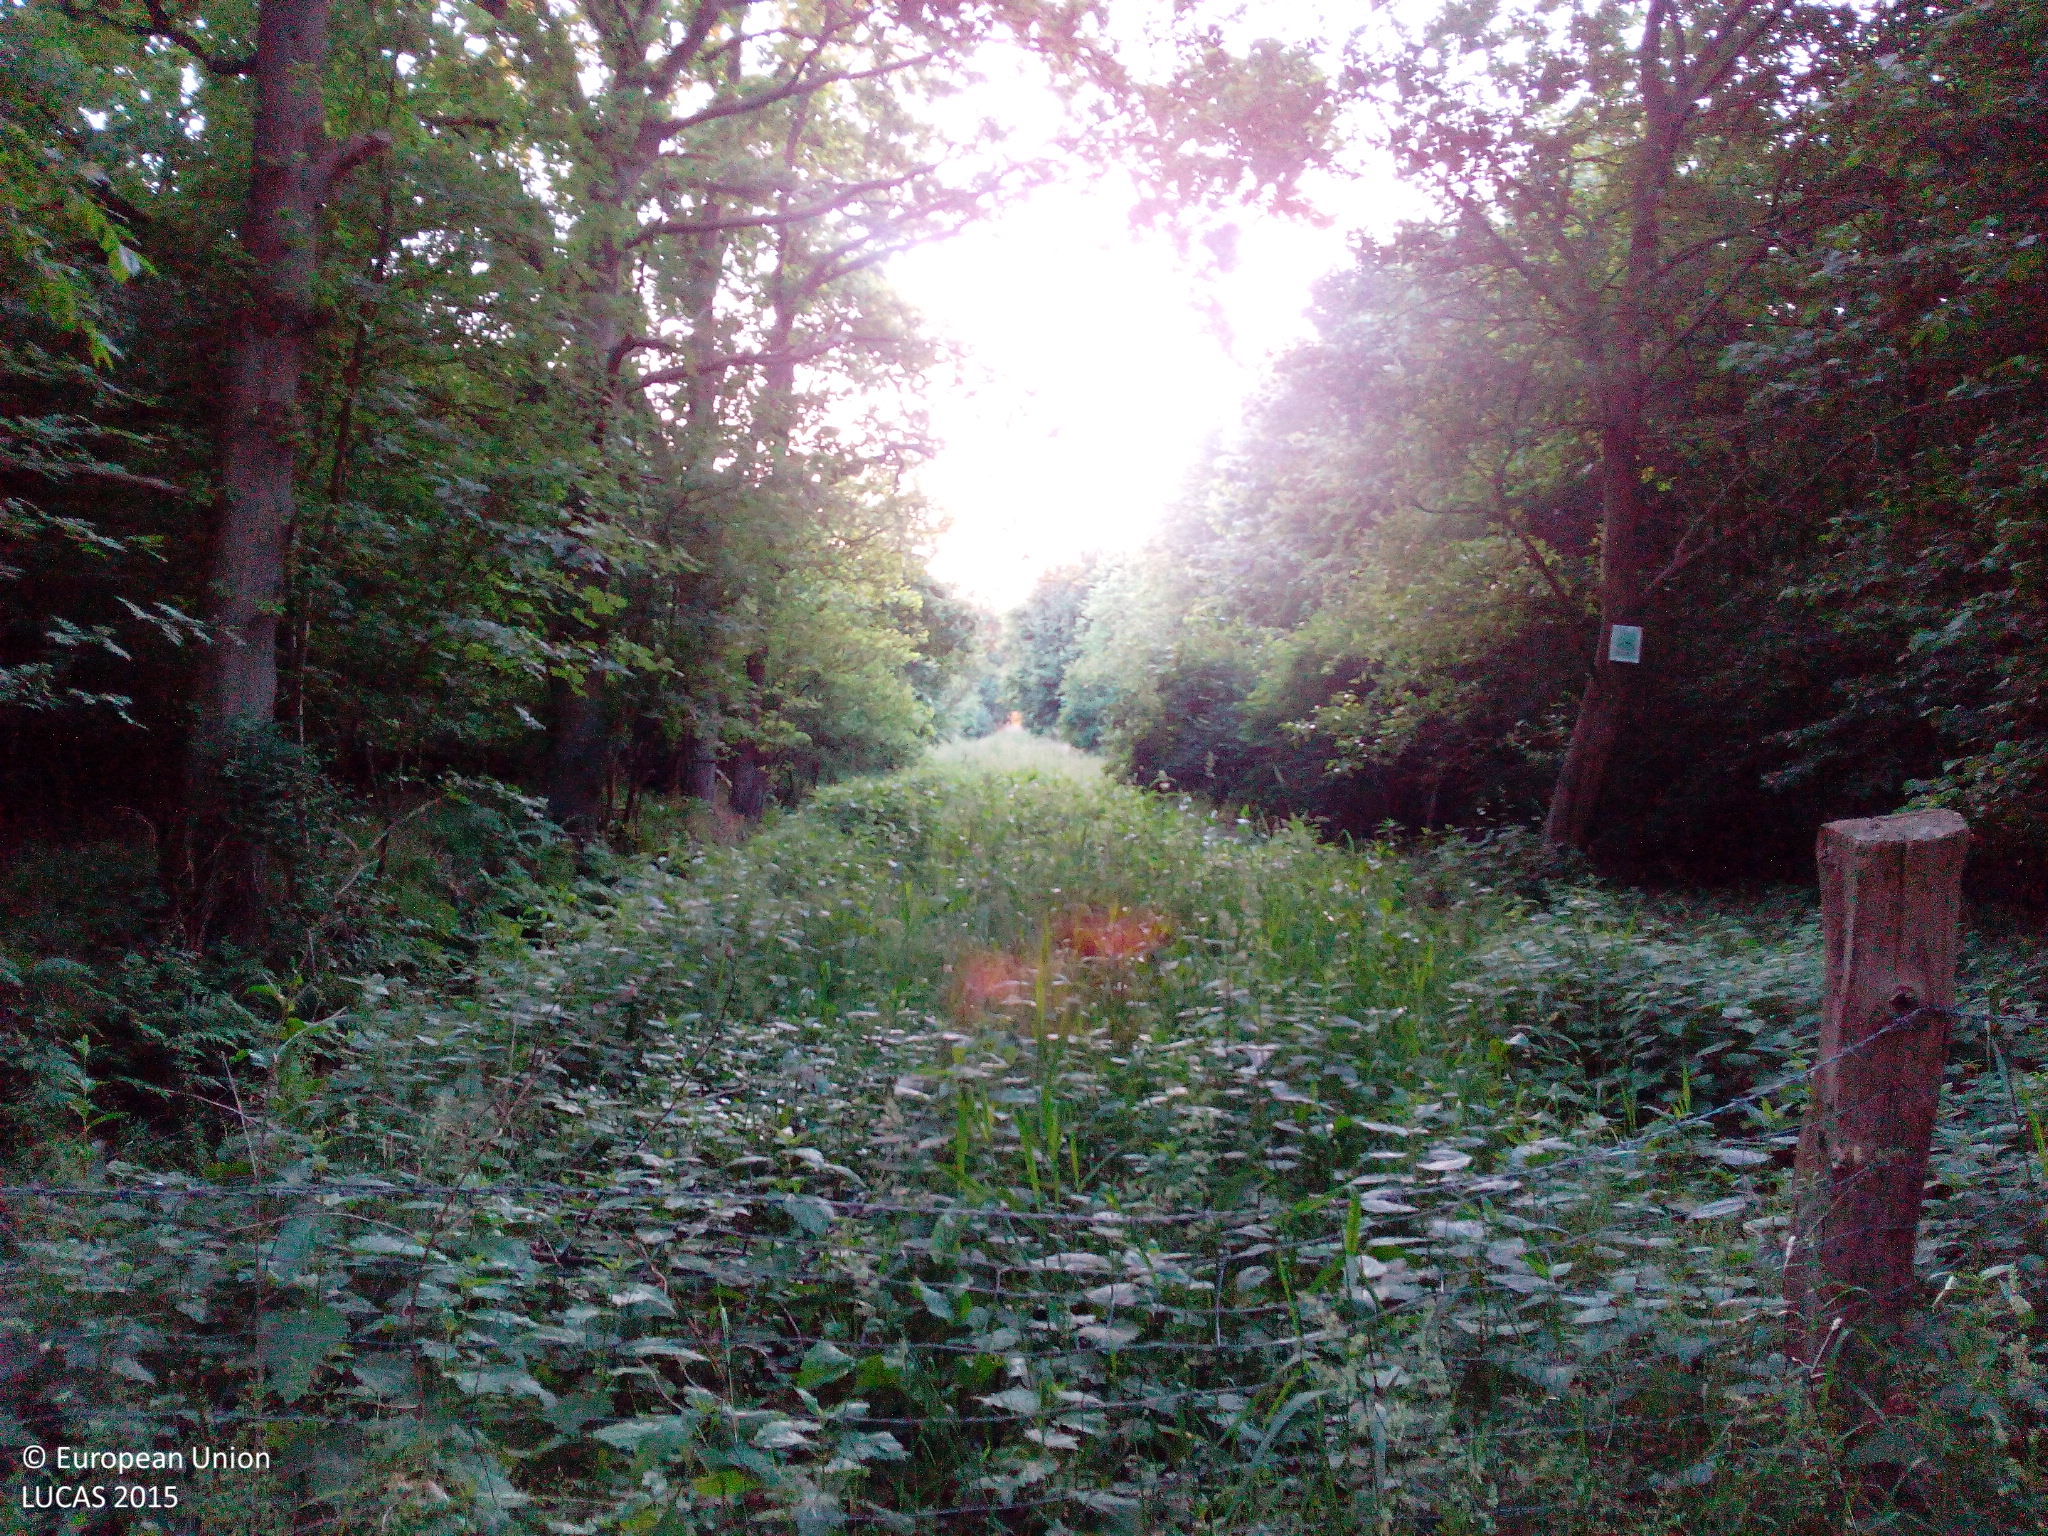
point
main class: Grassland
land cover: Spontaneously vegetated surfaces
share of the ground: > 75 %
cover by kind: herbaceous plants 95 %, shrubs 5 %
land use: Forestry
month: June
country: DE
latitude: 52.5639
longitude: 7.3597
